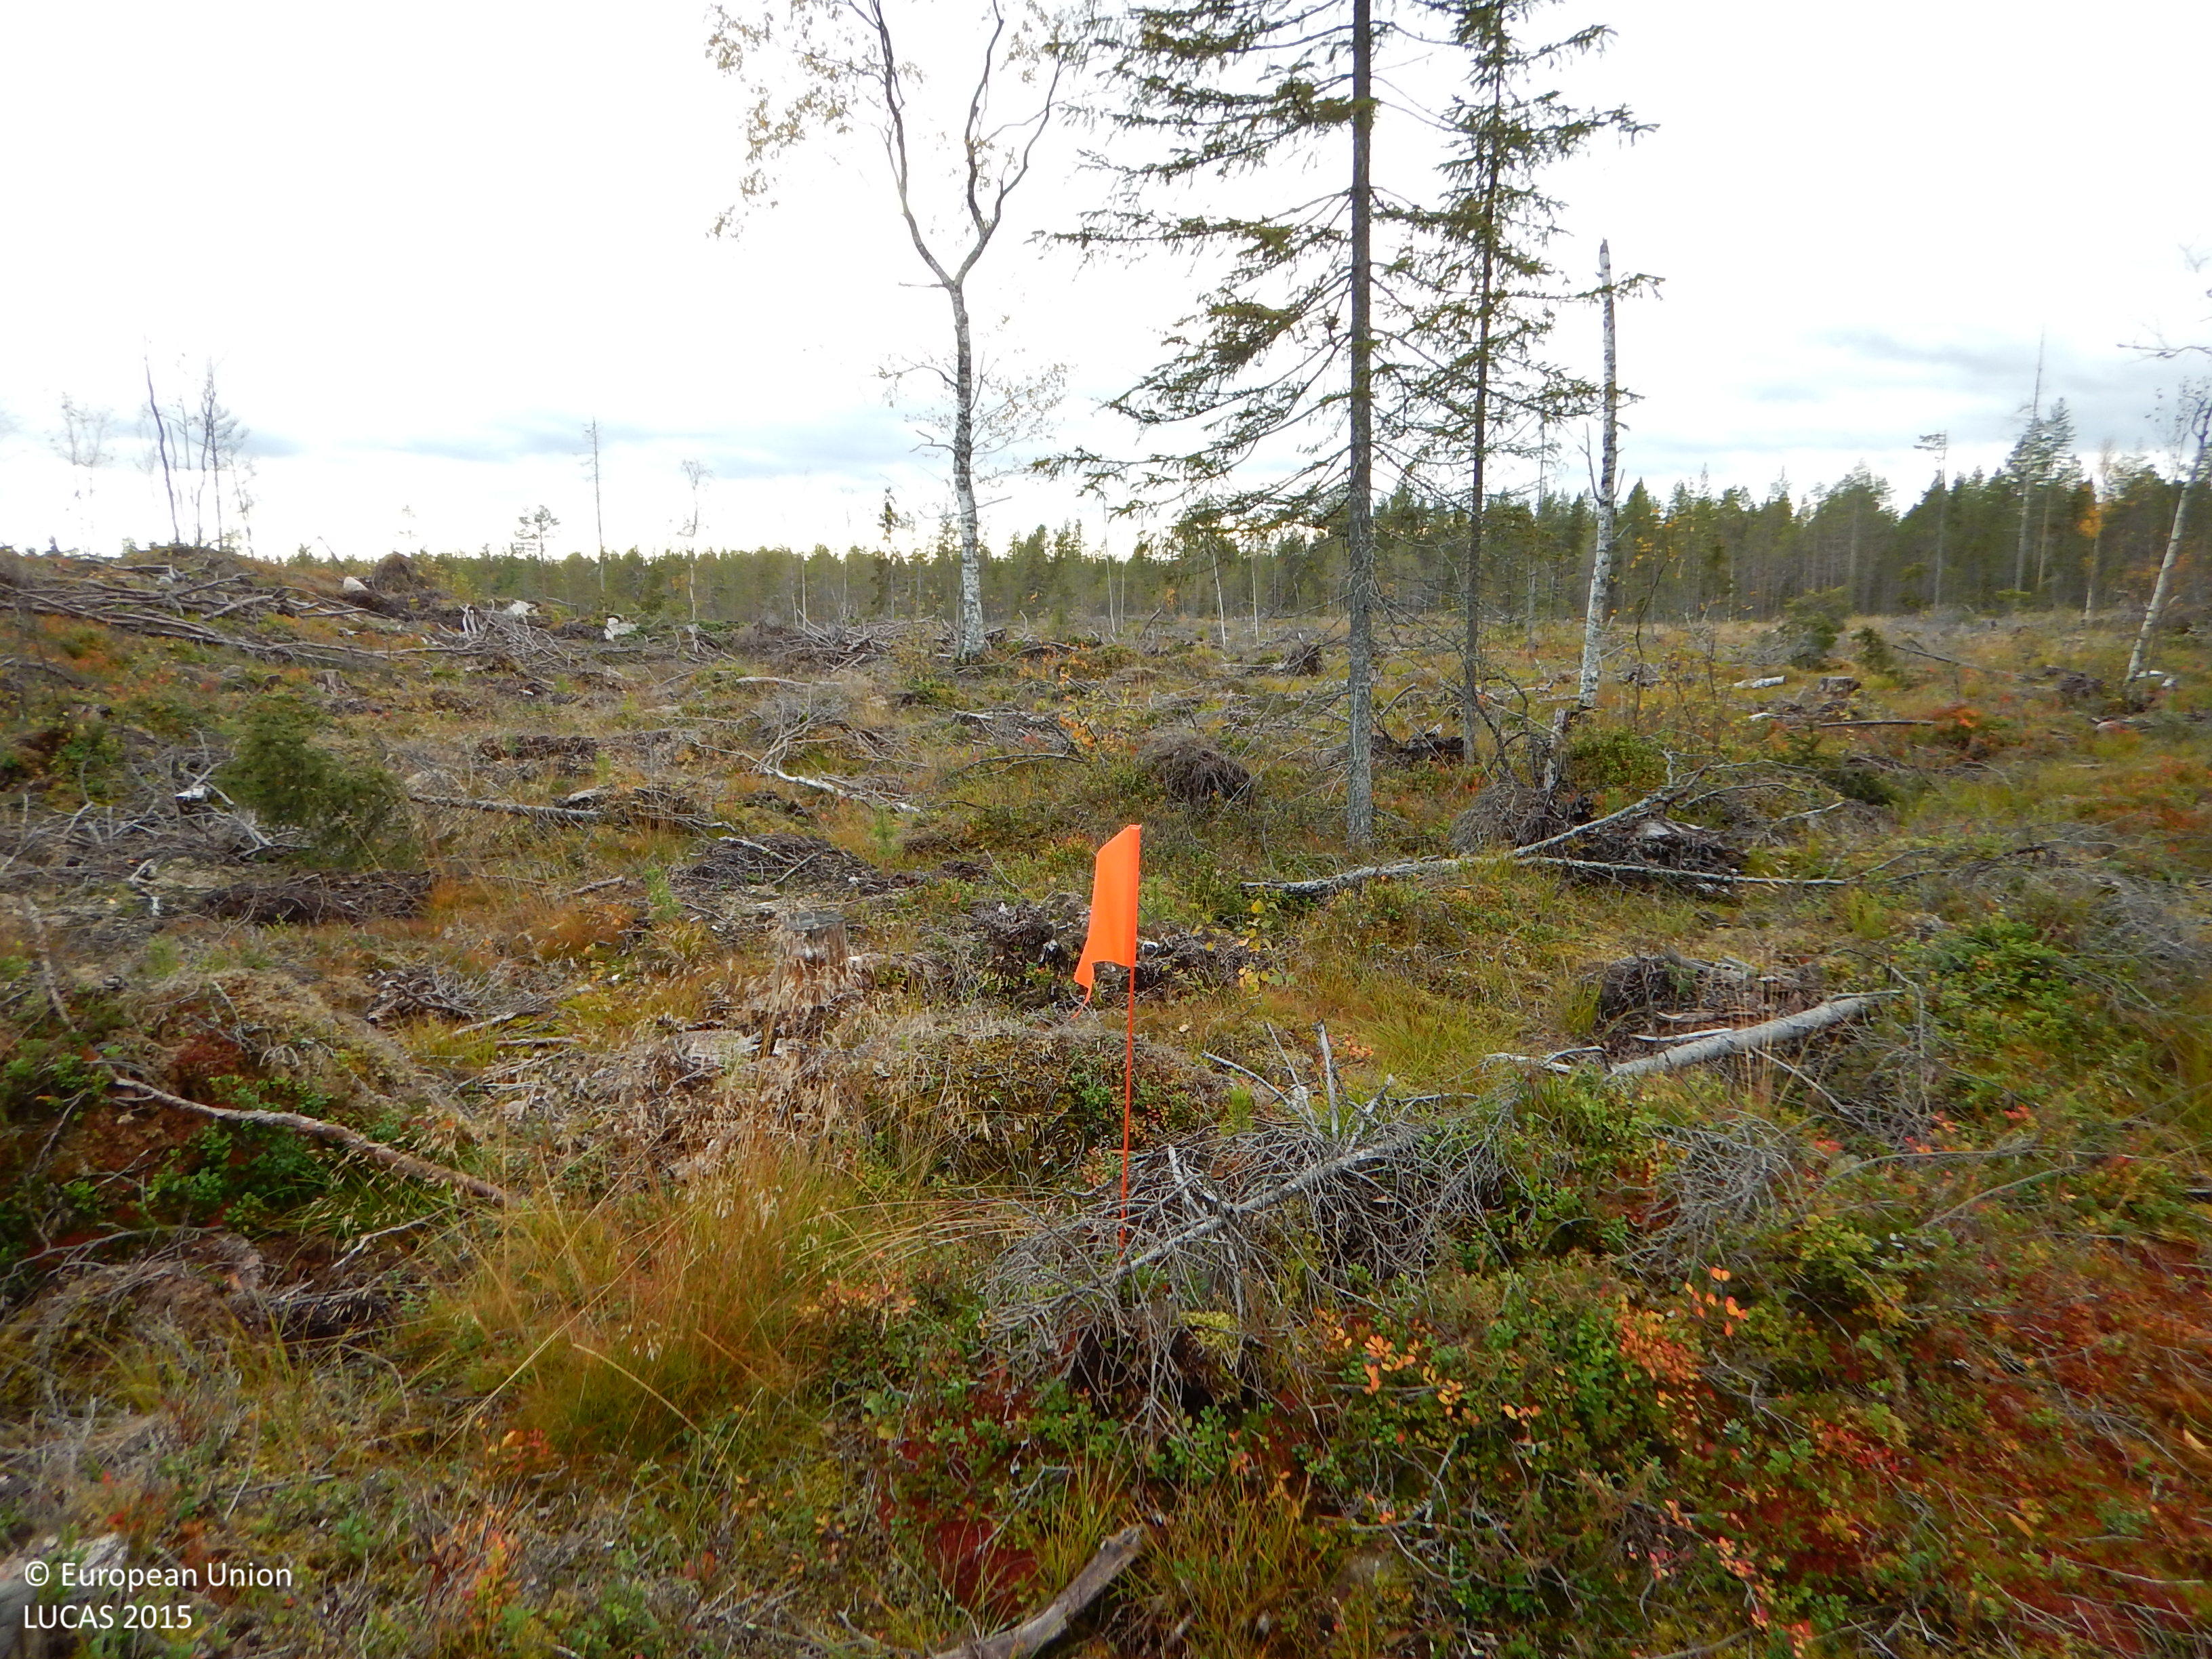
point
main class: Shrubland
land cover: Shrubland with sparse tree cover
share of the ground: 50 - 75 %
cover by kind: shrubs 40 %, herbaceous plants 40 %, lichens and mosses 15 %, coniferous forest trees 5 %
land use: Forestry
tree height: < 5 m
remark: Clear cut
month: September
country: SE
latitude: 65.0316
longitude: 20.2679
